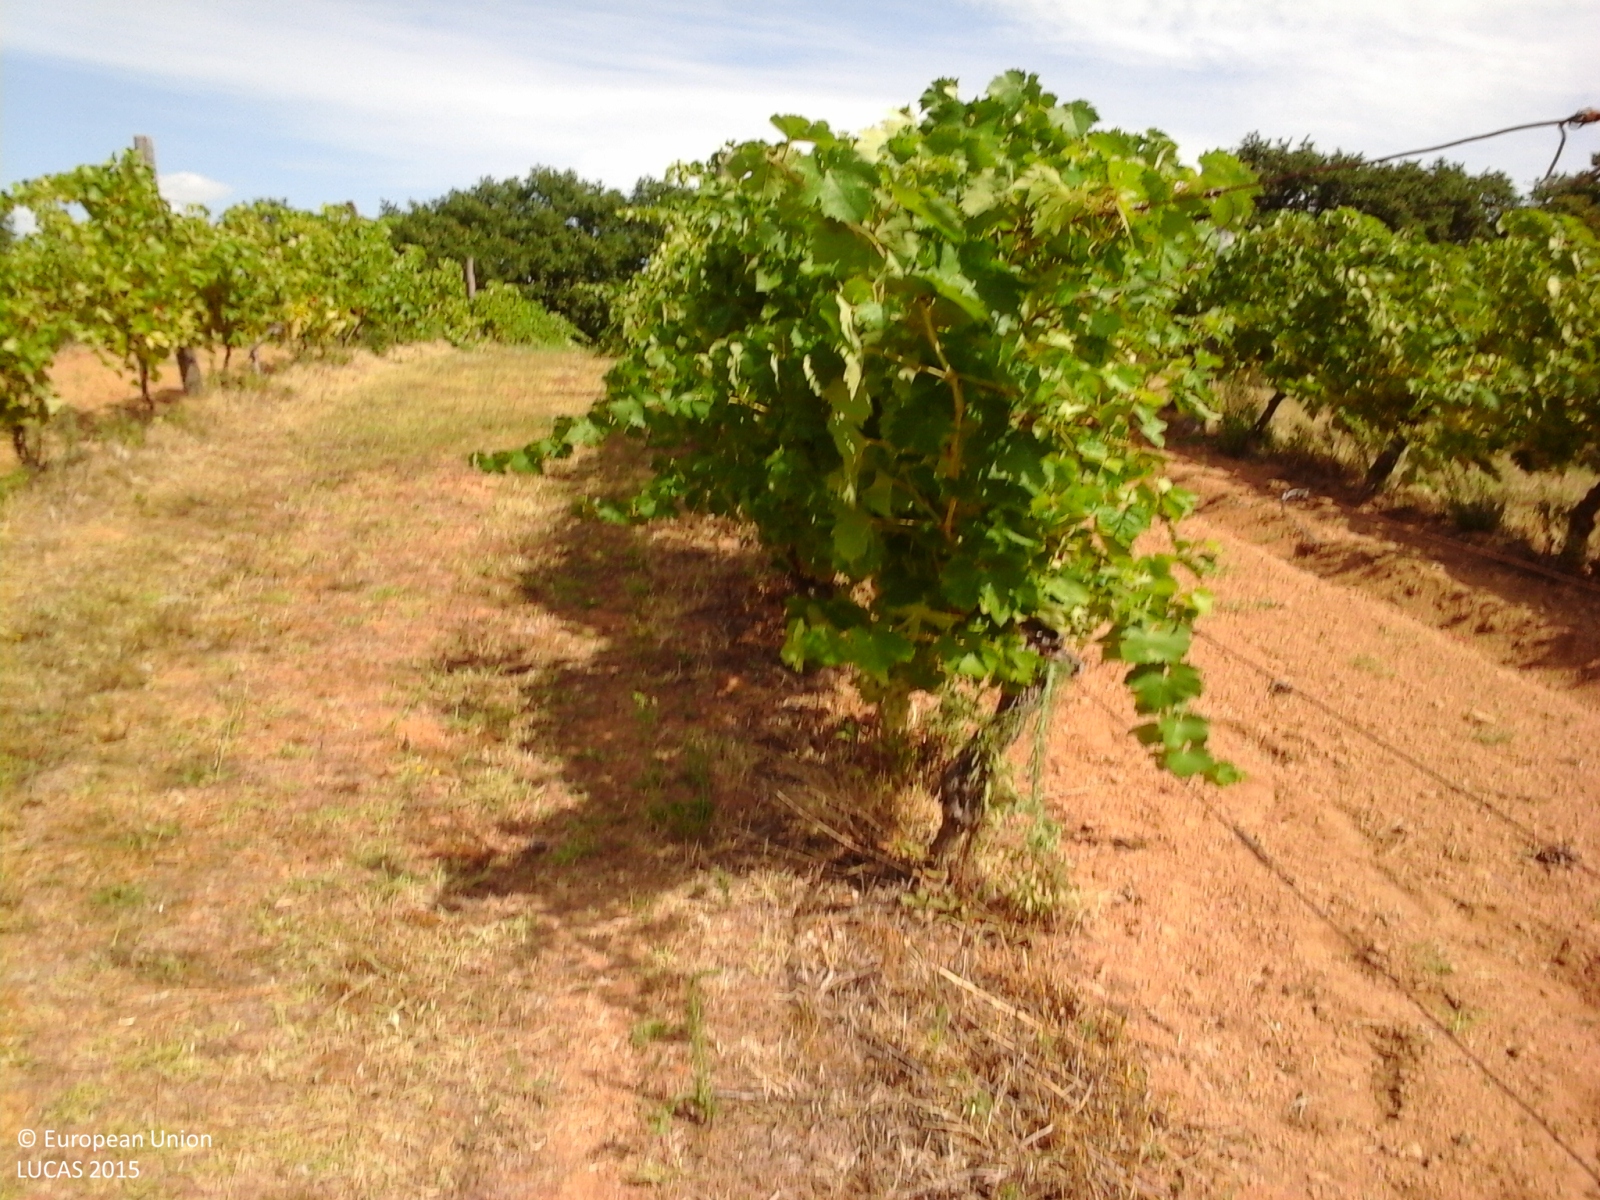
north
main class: Cropland
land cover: Vineyards
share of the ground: 25 - 50 %
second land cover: Grassland without tree/shrub cover
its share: > 75 %
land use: Agriculture (excluding fallow land and kitchen gardens)
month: August
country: IT
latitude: 42.6231
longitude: 11.6162
